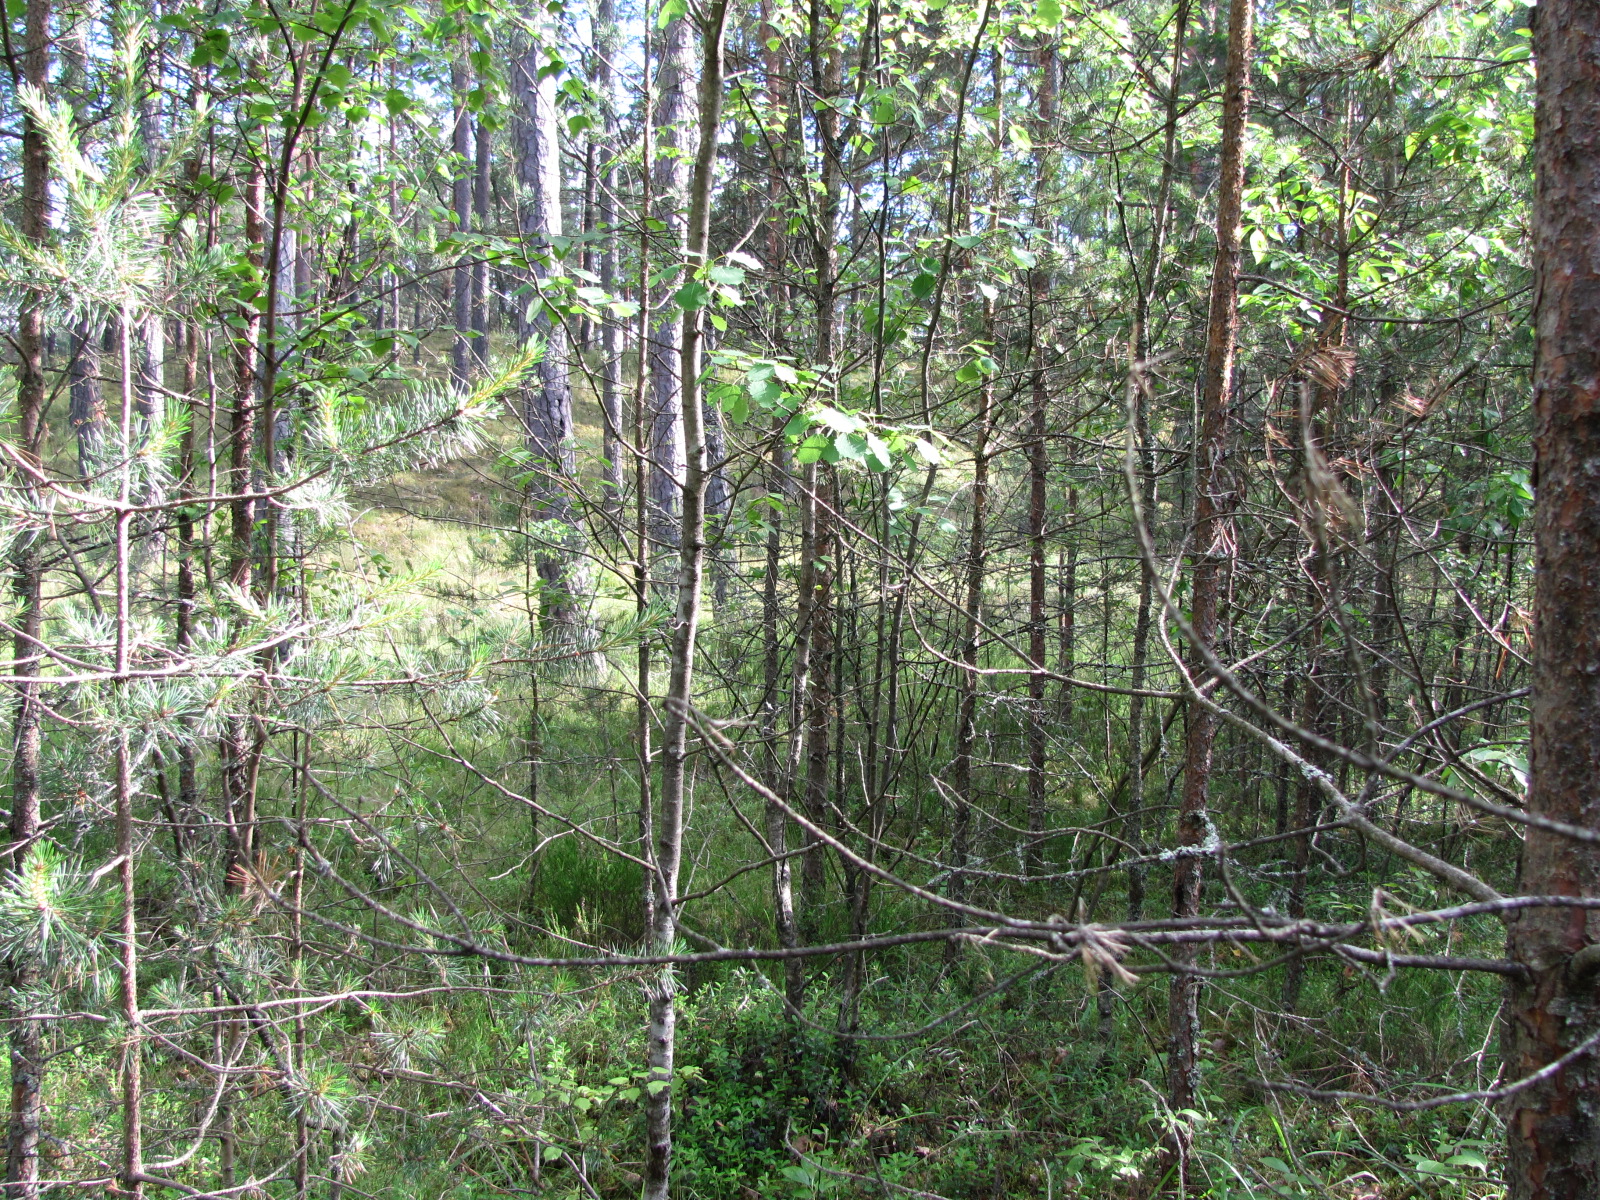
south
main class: Woodland
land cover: Pine dominated coniferous woodland
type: hemiboreal forest and nemoral coniferous forest and mixed broadleaved-coniferous forest
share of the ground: > 75 %
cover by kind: coniferous forest trees 80 %, herbaceous plants 10 %, broadleaved forest trees 5 %, lichens and mosses 5 %
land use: Forestry
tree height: > 5 m
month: June
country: LV
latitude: 57.0063
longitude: 23.9961
